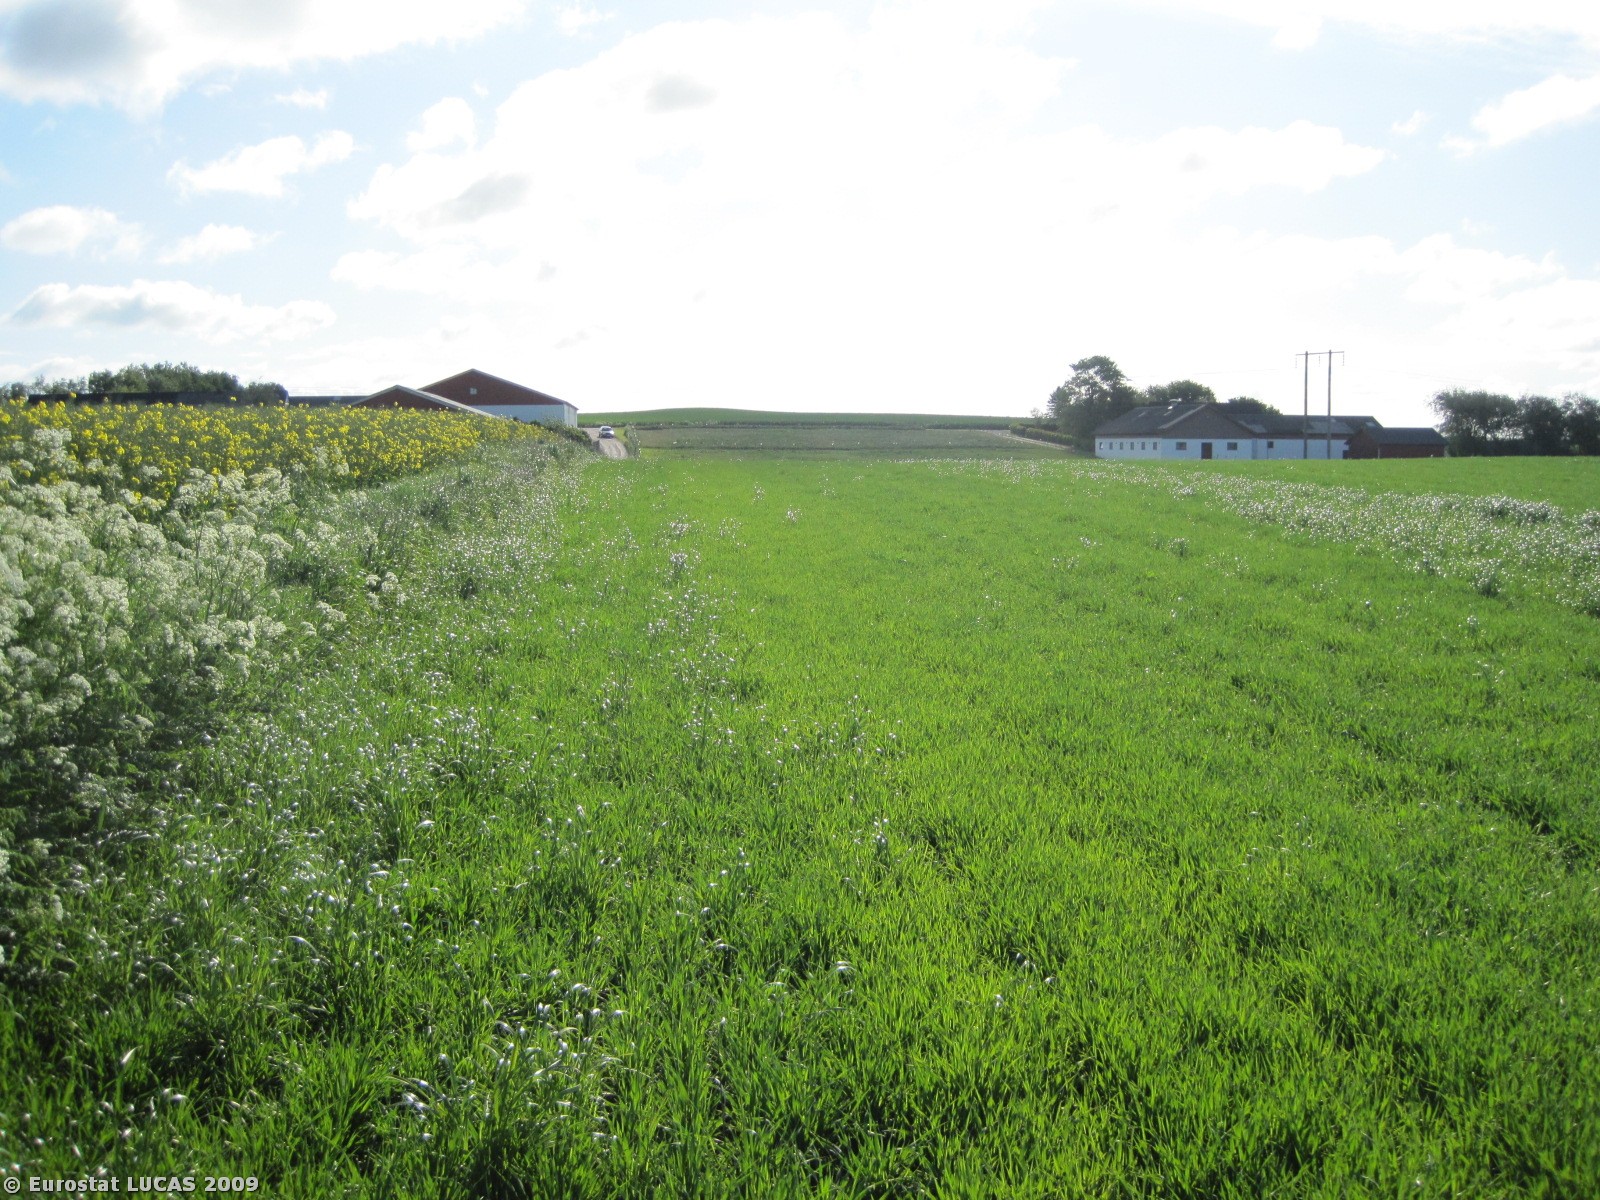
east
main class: Cropland
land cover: Barley
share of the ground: > 75 %
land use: Agriculture (excluding fallow land and kitchen gardens)
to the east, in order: Barley; Electric lines; Barley; Fences; Grassland without tree/shrub cover; Fences; Grassland without tree/shrub cover
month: May
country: DK
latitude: 56.8888
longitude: 9.9836
